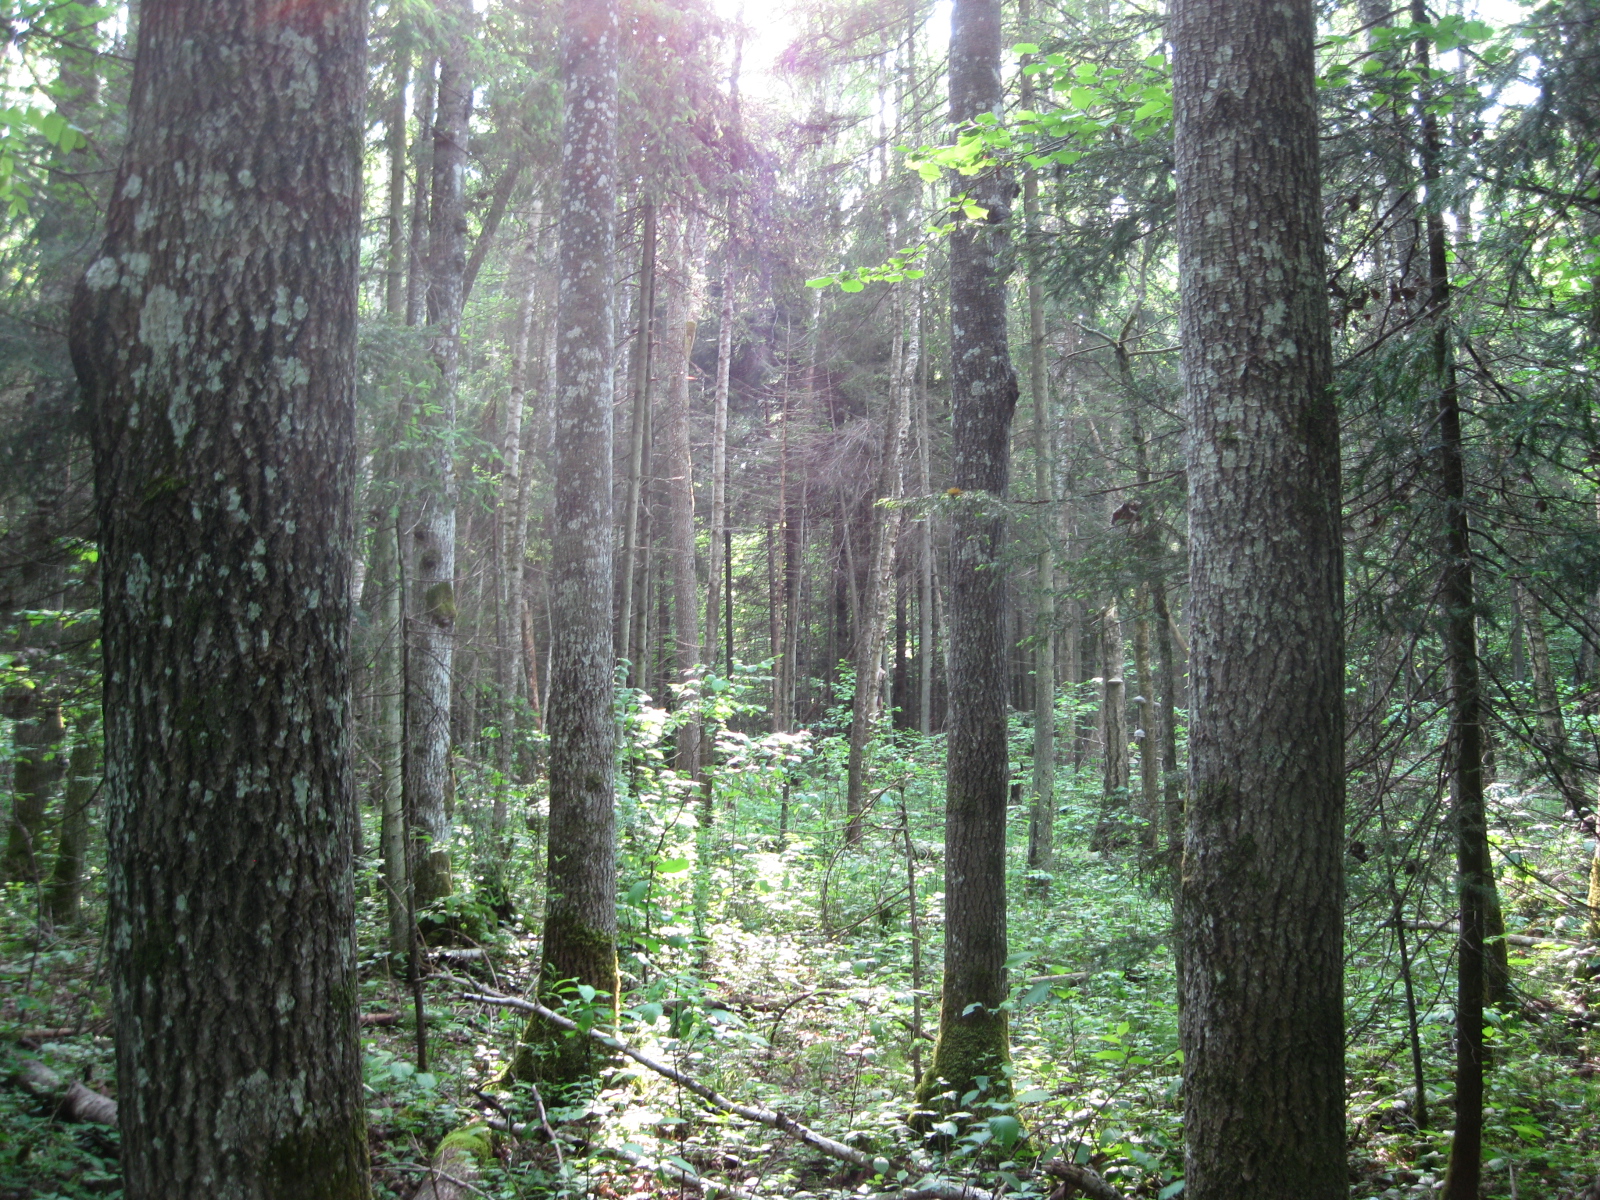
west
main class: Woodland
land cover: Spruce dominated mixed woodland
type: hemiboreal forest and nemoral coniferous forest and mixed broadleaved-coniferous forest
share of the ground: > 75 %
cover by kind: broadleaved forest trees 50 %, coniferous forest trees 35 %, herbaceous plants 10 %, shrubs 5 %
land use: Forestry
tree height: > 5 m
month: June
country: LT
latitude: 55.9412
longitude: 23.8698
